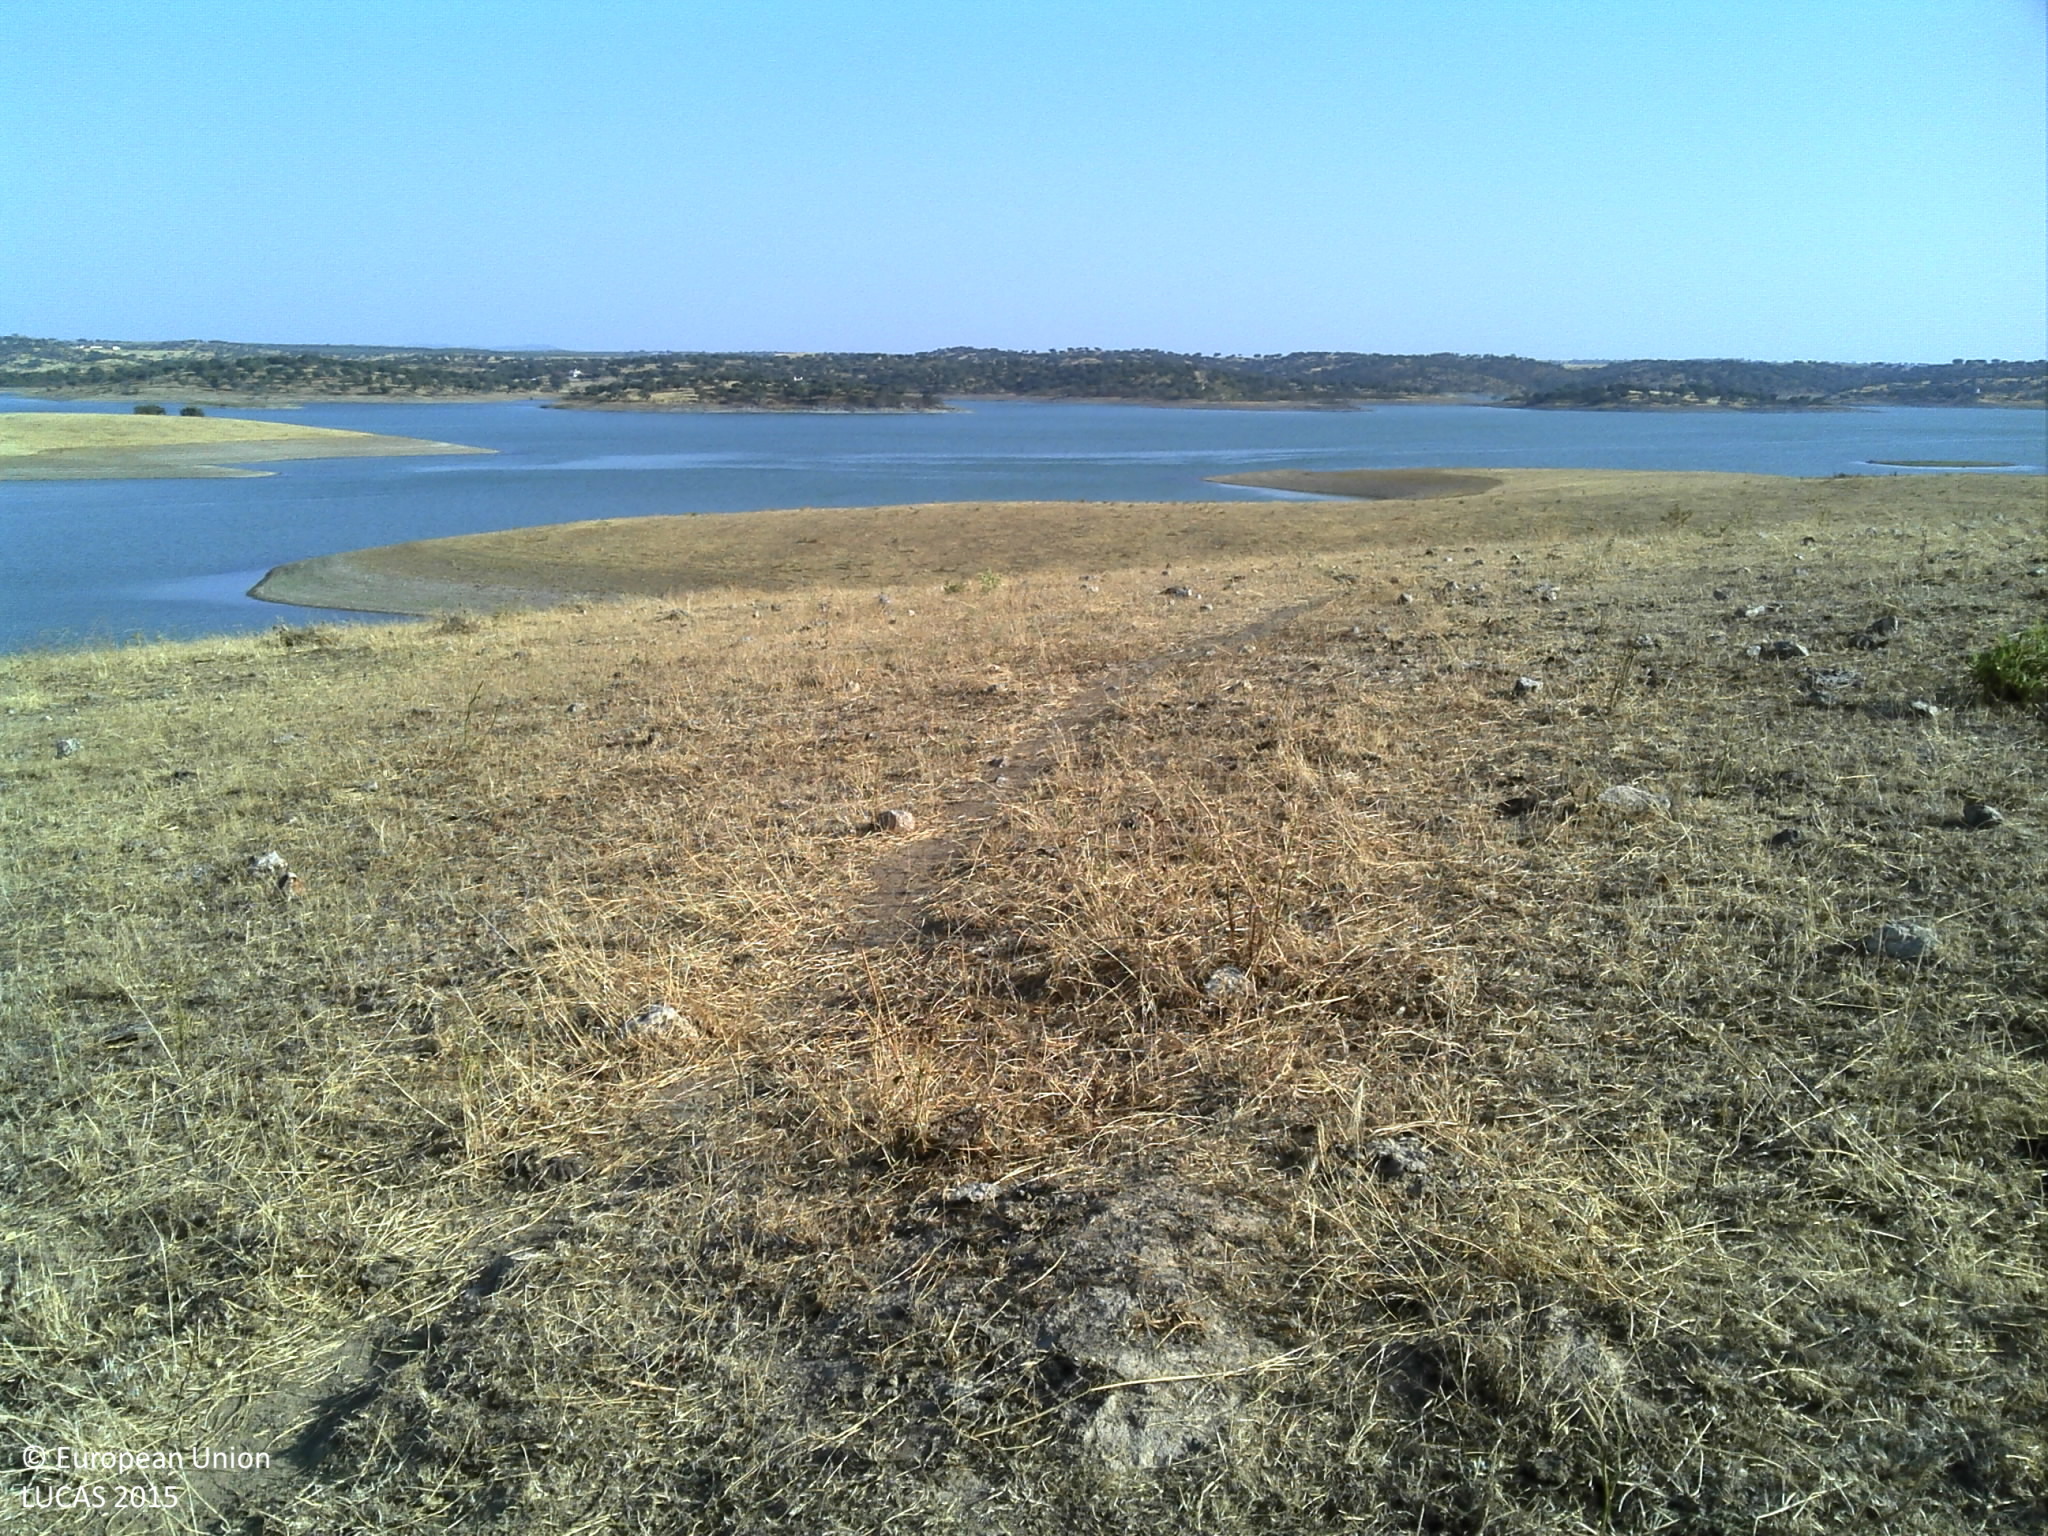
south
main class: Grassland
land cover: Grassland without tree/shrub cover
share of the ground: 10 - 25 %
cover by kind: herbaceous plants 100 %
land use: Agriculture (excluding fallow land and kitchen gardens)
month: June
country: PT
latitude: 38.2593
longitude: -7.3811
